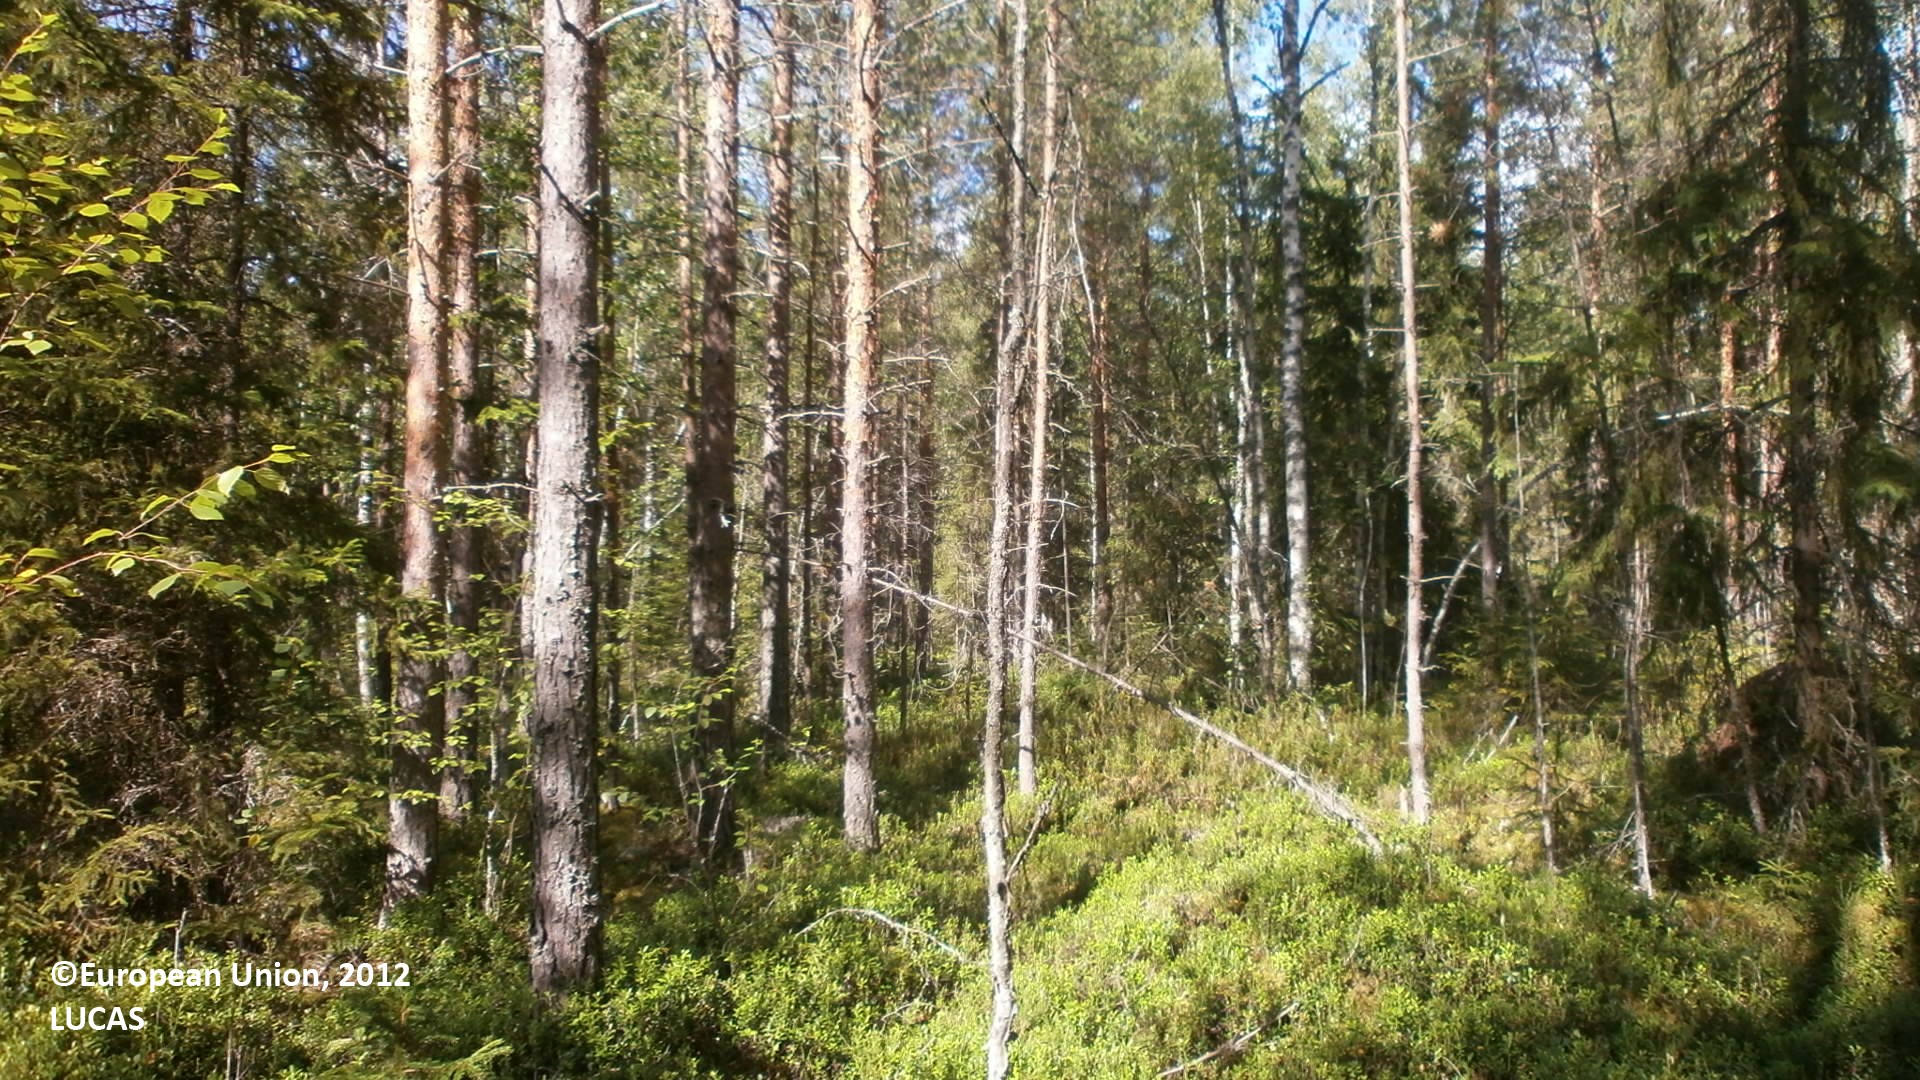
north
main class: Woodland
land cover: Pine dominated coniferous woodland
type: boreal forest
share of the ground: 50 - 75 %
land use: Forestry
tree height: > 5 m
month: July
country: FI
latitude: 63.9851
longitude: 23.8983
